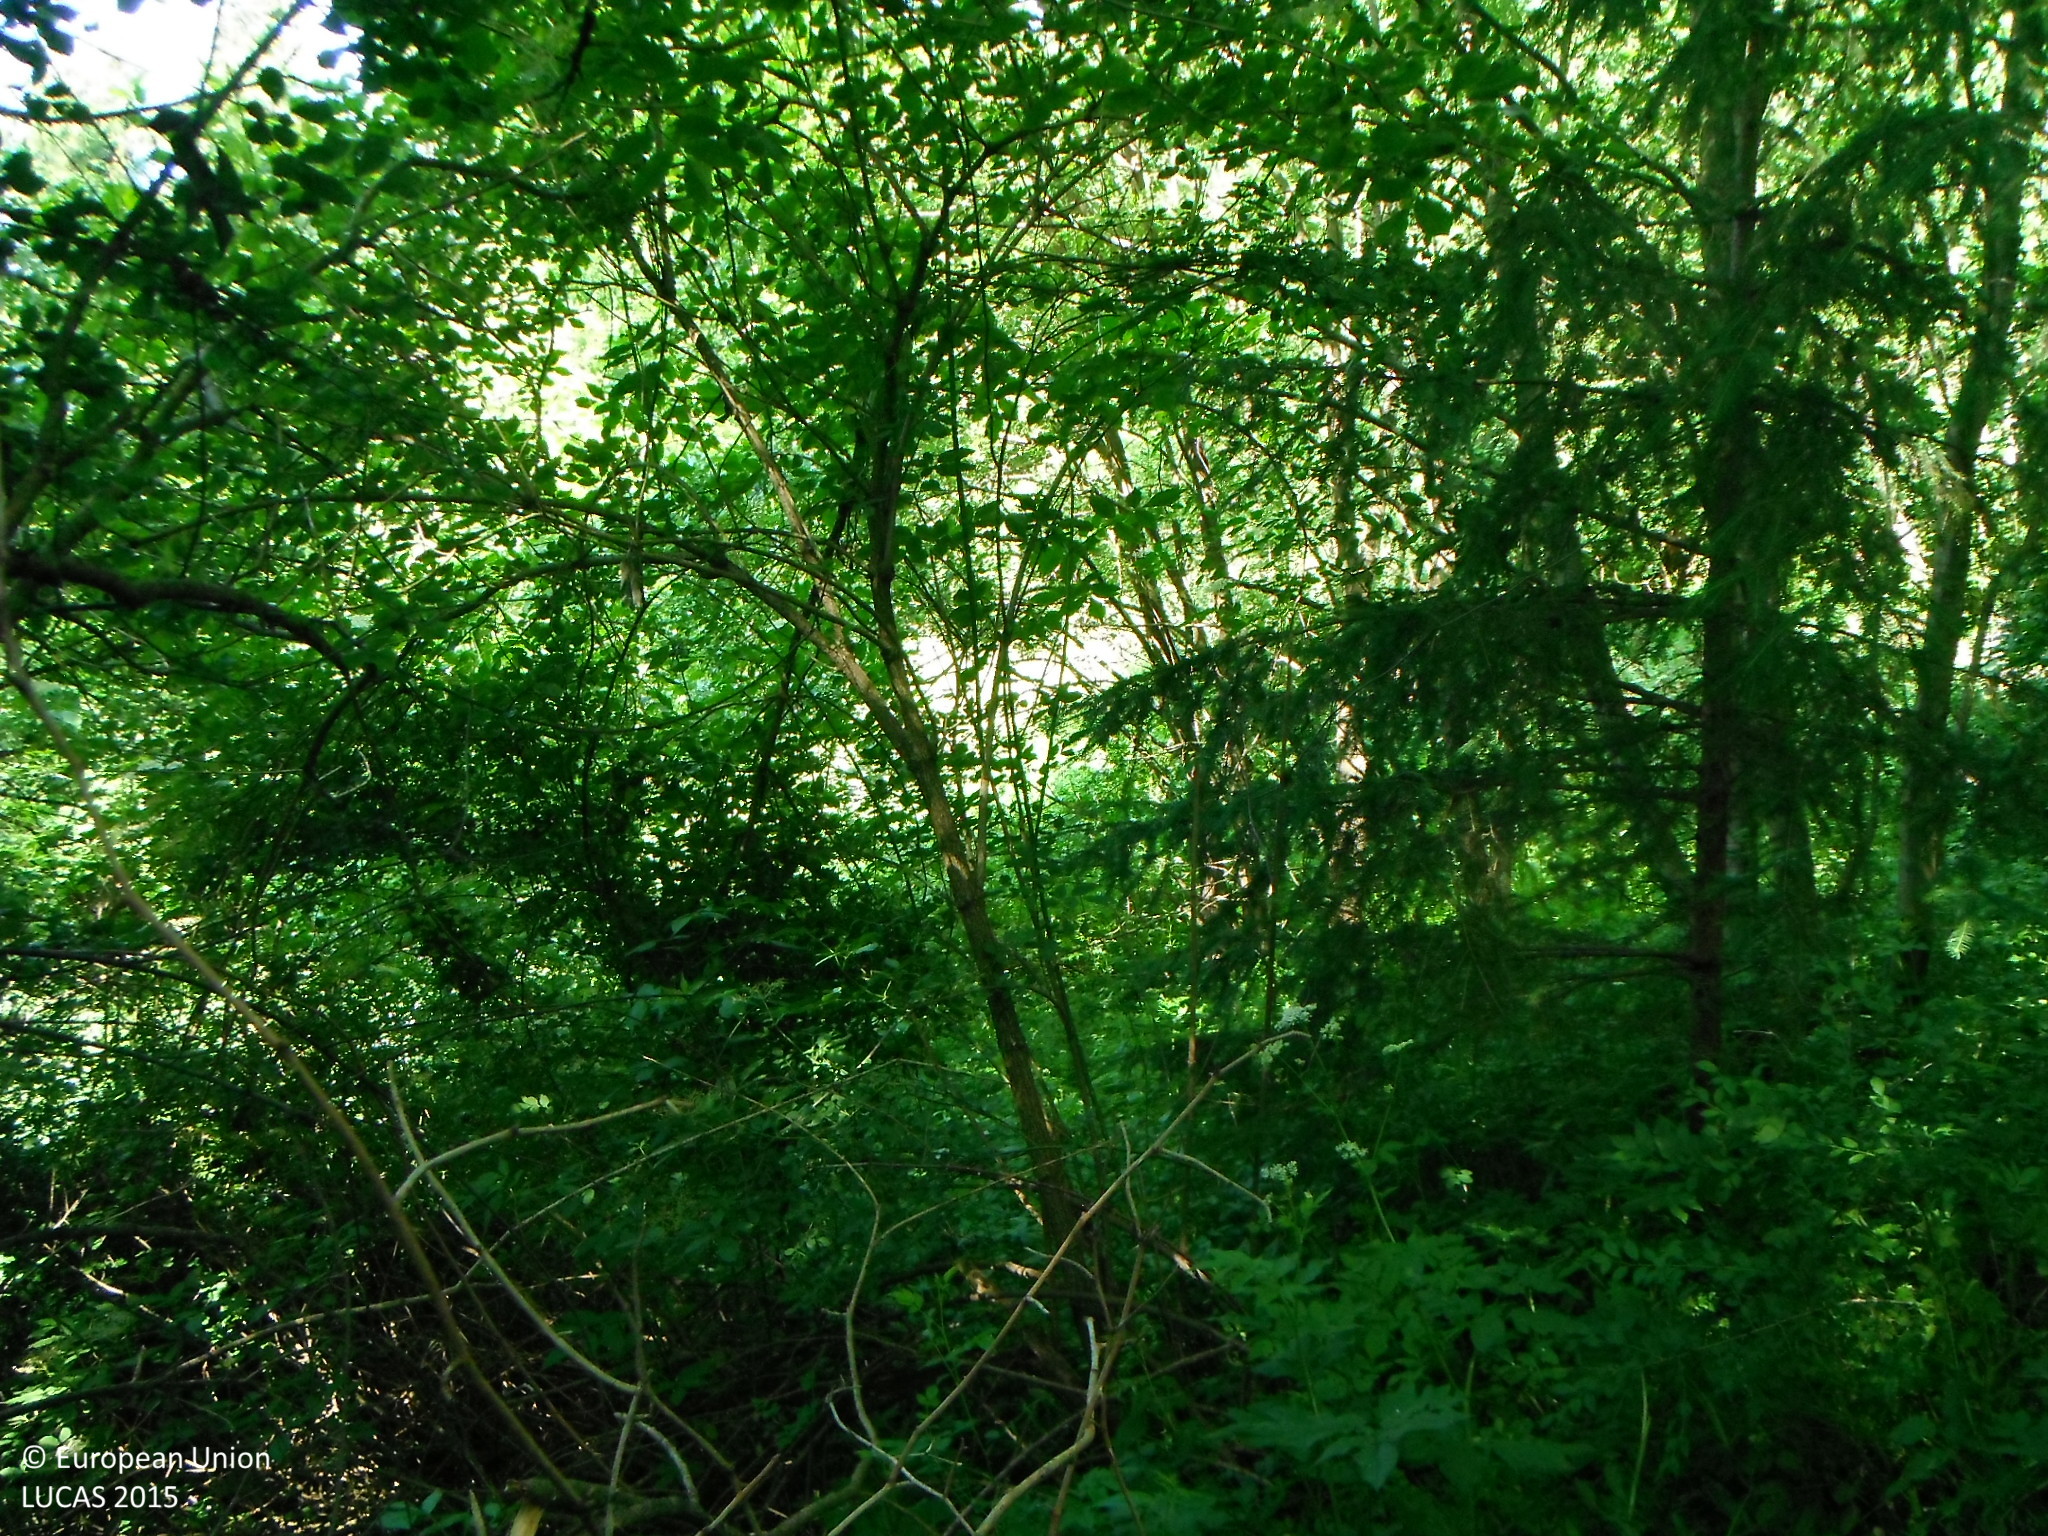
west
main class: Woodland
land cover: Broadleaved woodland
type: hemiboreal forest and nemoral coniferous forest and mixed broadleaved-coniferous forest
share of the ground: > 75 %
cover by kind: broadleaved forest trees 95 %, coniferous forest trees 5 %
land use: Semi-natural and natural areas not in use
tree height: > 5 m
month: June
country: SK
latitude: 49.2264
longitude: 19.4871
